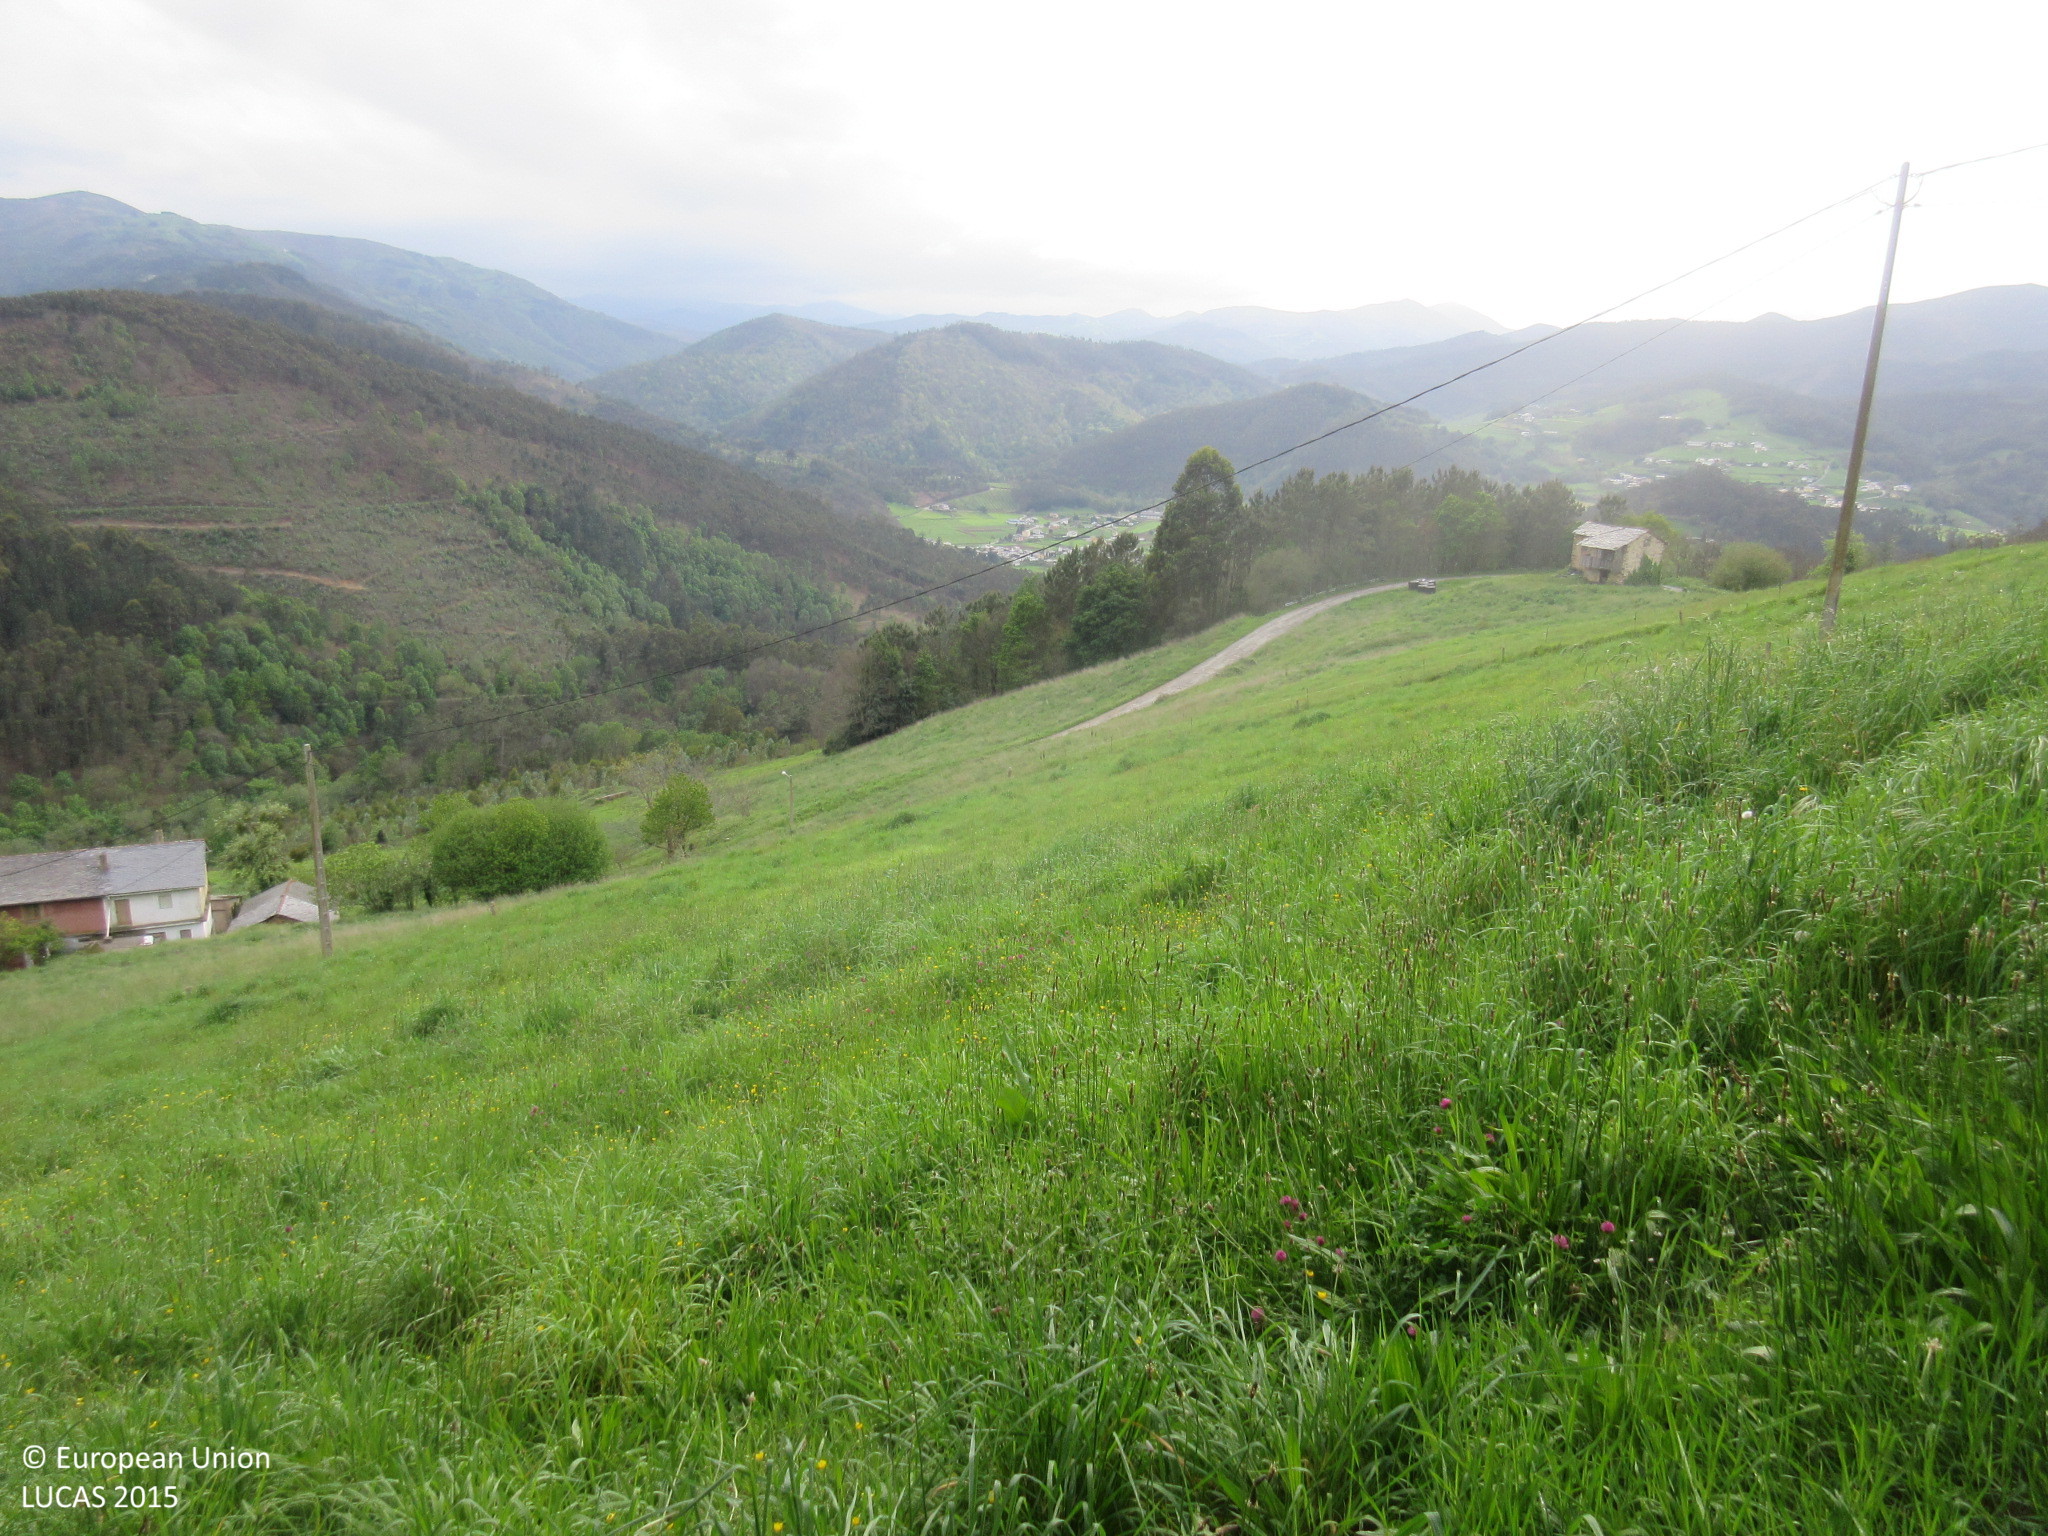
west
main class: Grassland
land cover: Grassland without tree/shrub cover
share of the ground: > 75 %
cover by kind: herbaceous plants 100 %
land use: Agriculture (excluding fallow land and kitchen gardens)
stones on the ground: 10 - 25 %
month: April
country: ES
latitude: 43.4923
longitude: -6.4130
